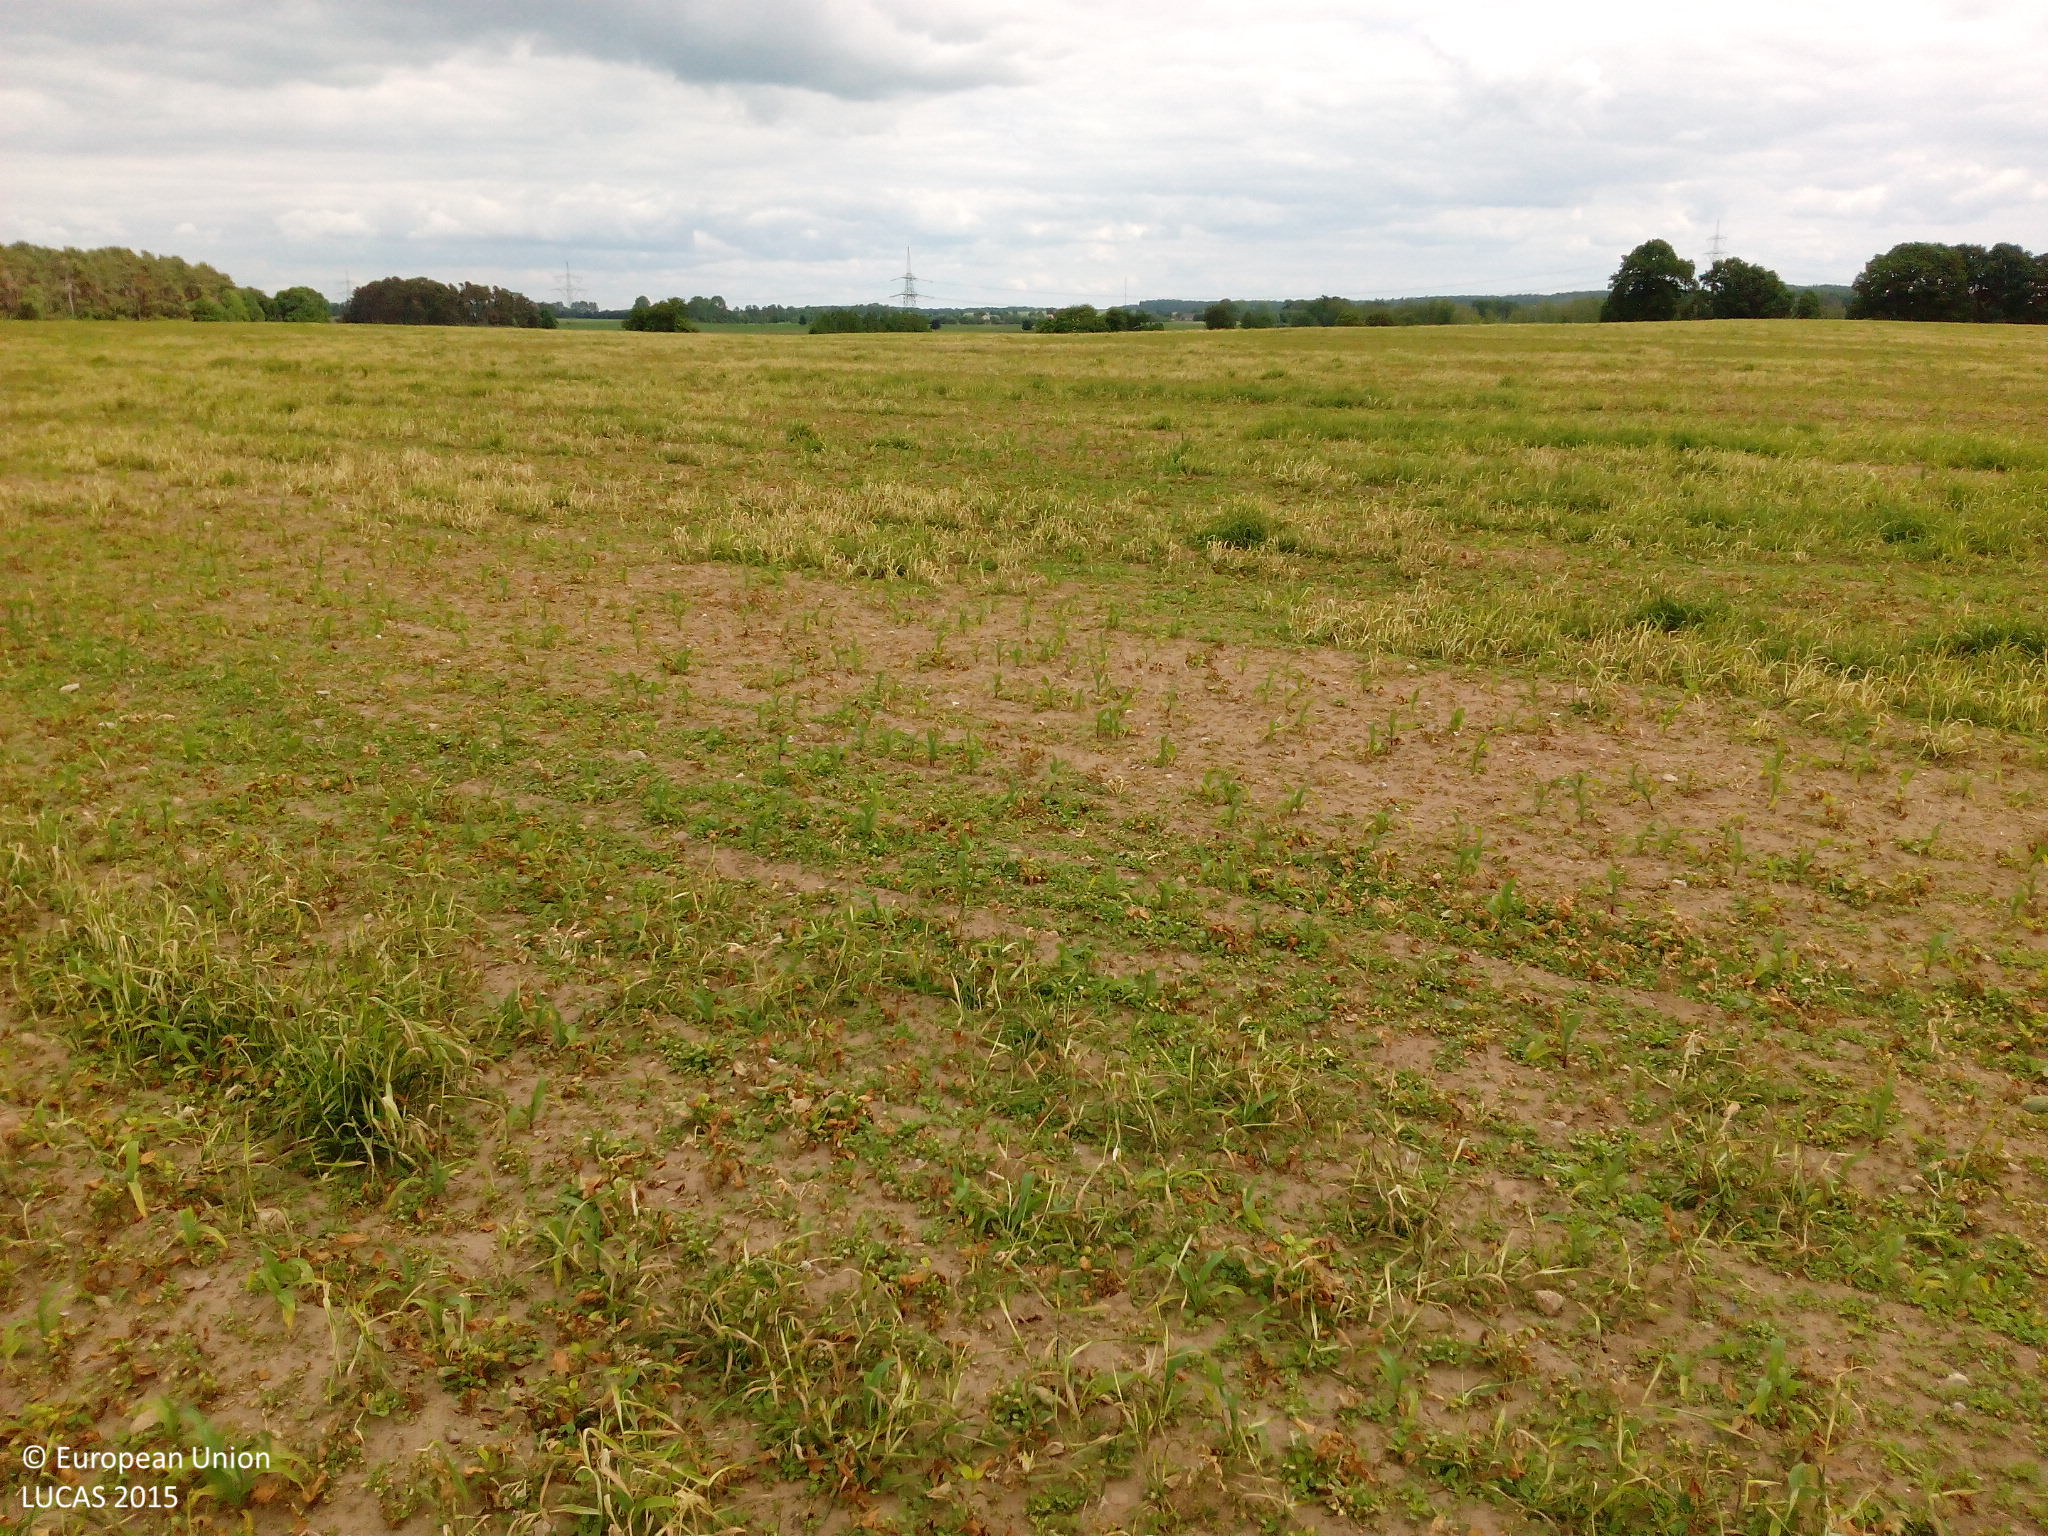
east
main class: Cropland
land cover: Maize
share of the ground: < 10 %
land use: Agriculture (excluding fallow land and kitchen gardens)
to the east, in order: Maize
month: June
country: DE
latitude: 53.3969
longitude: 12.3604
